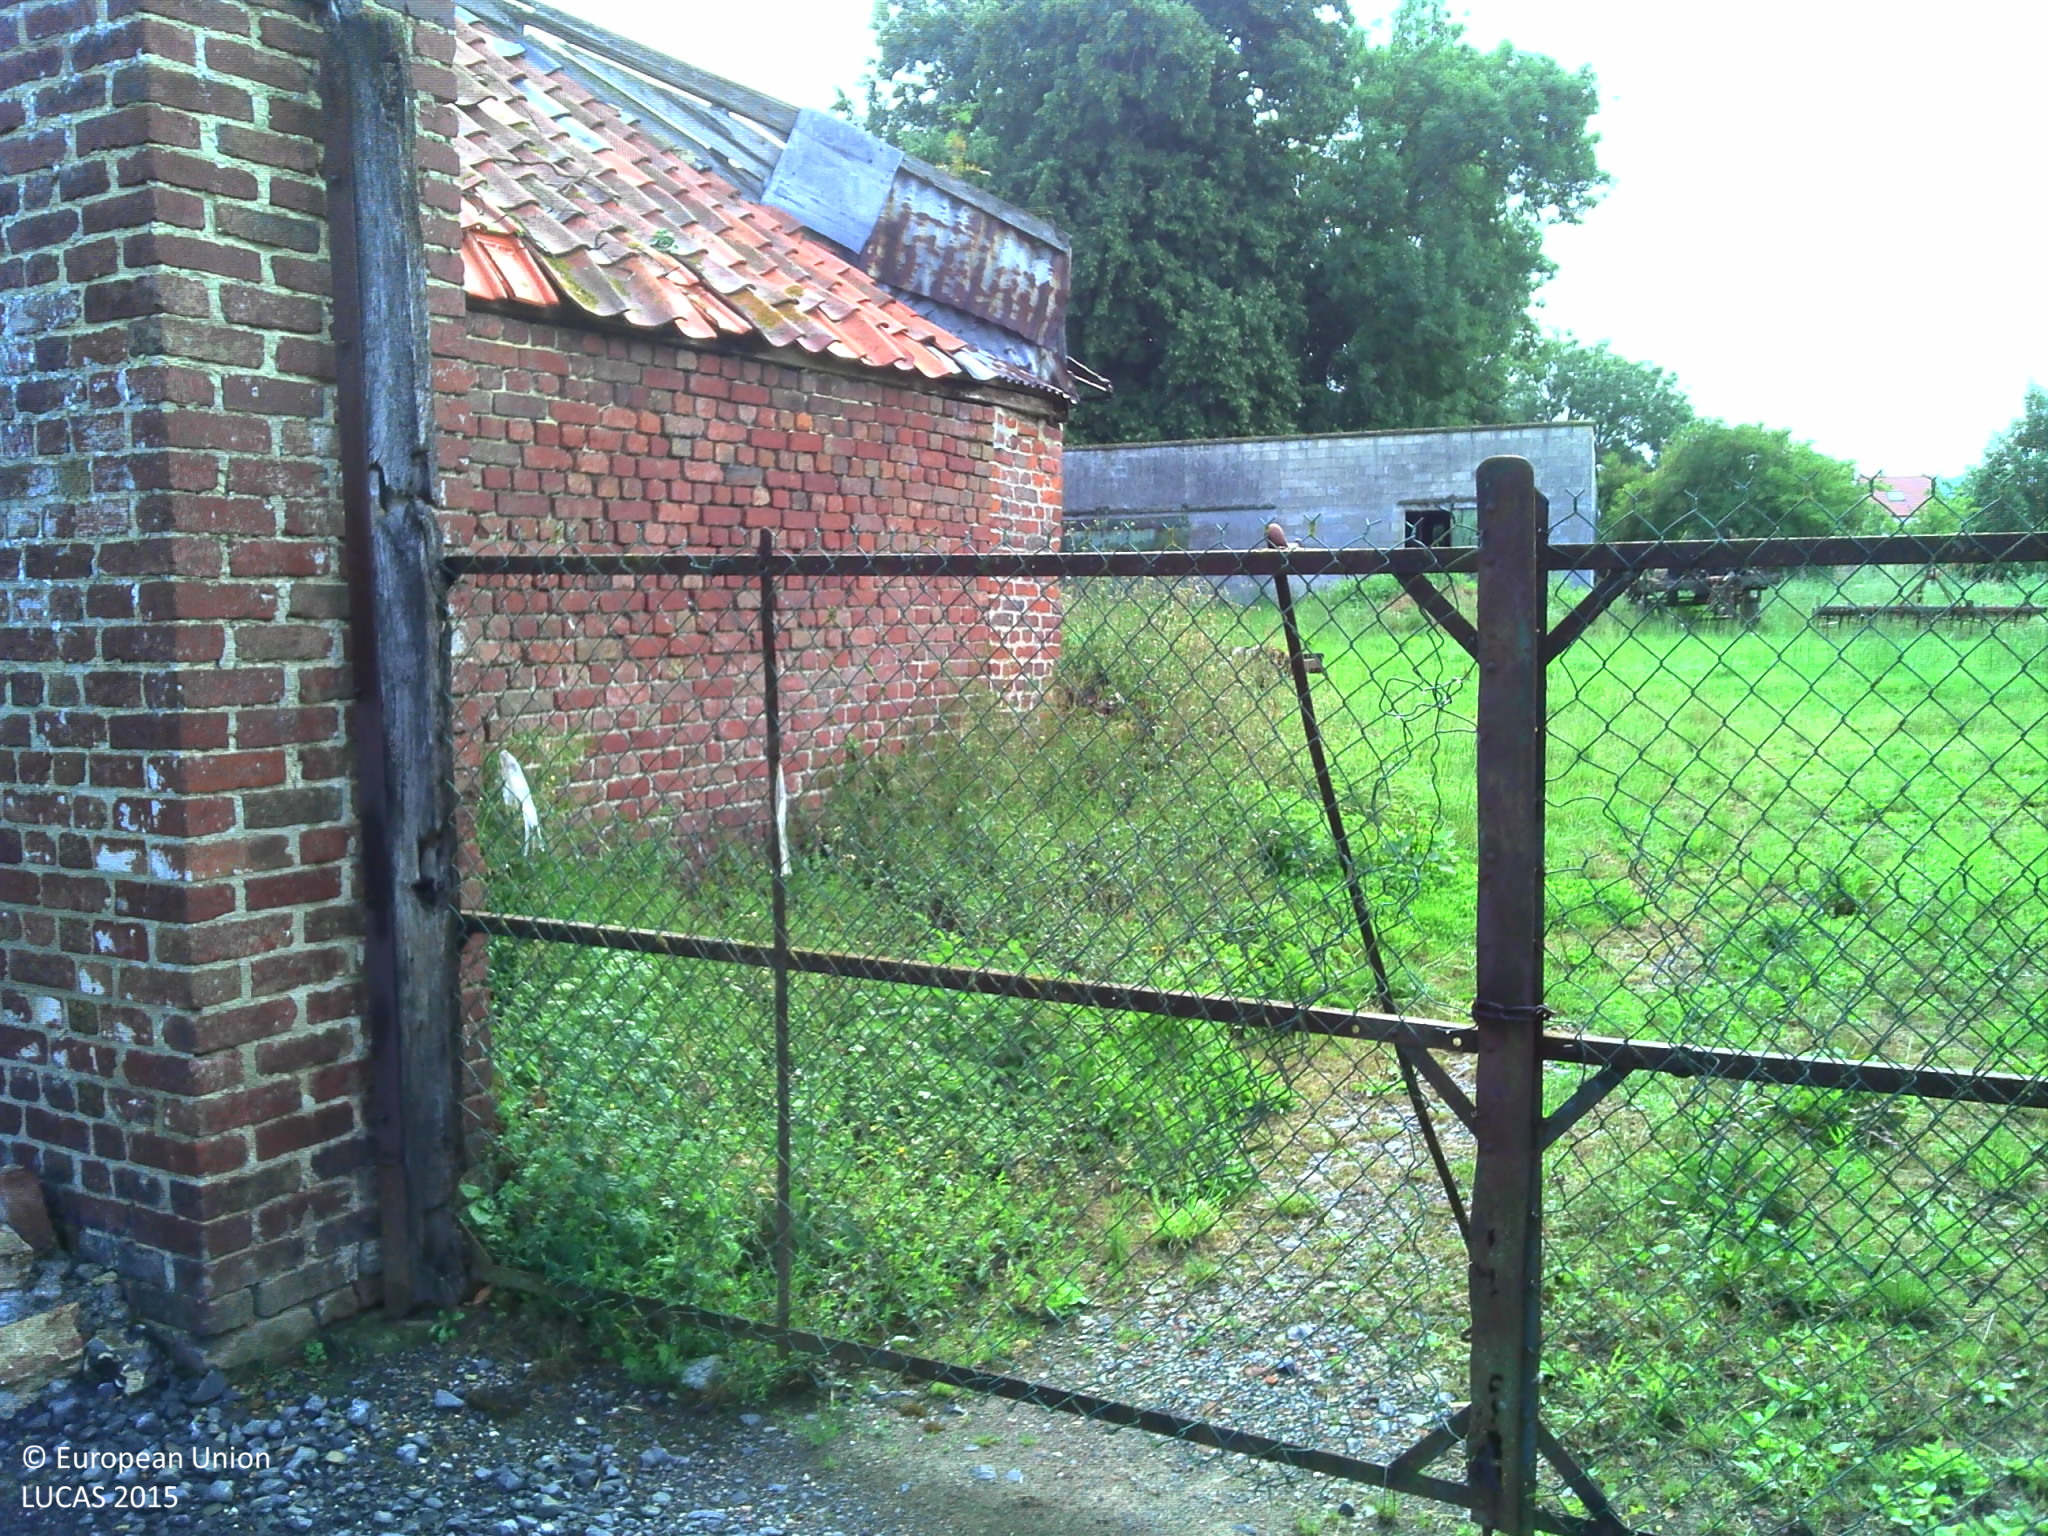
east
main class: Woodland
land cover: Broadleaved woodland
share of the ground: > 75 %
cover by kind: broadleaved forest trees 85 %, herbaceous plants 15 %
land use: Residential
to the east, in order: Broadleaved woodland; Artificial constructions in urban areas
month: July
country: FR
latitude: 50.3292
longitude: 3.6011
